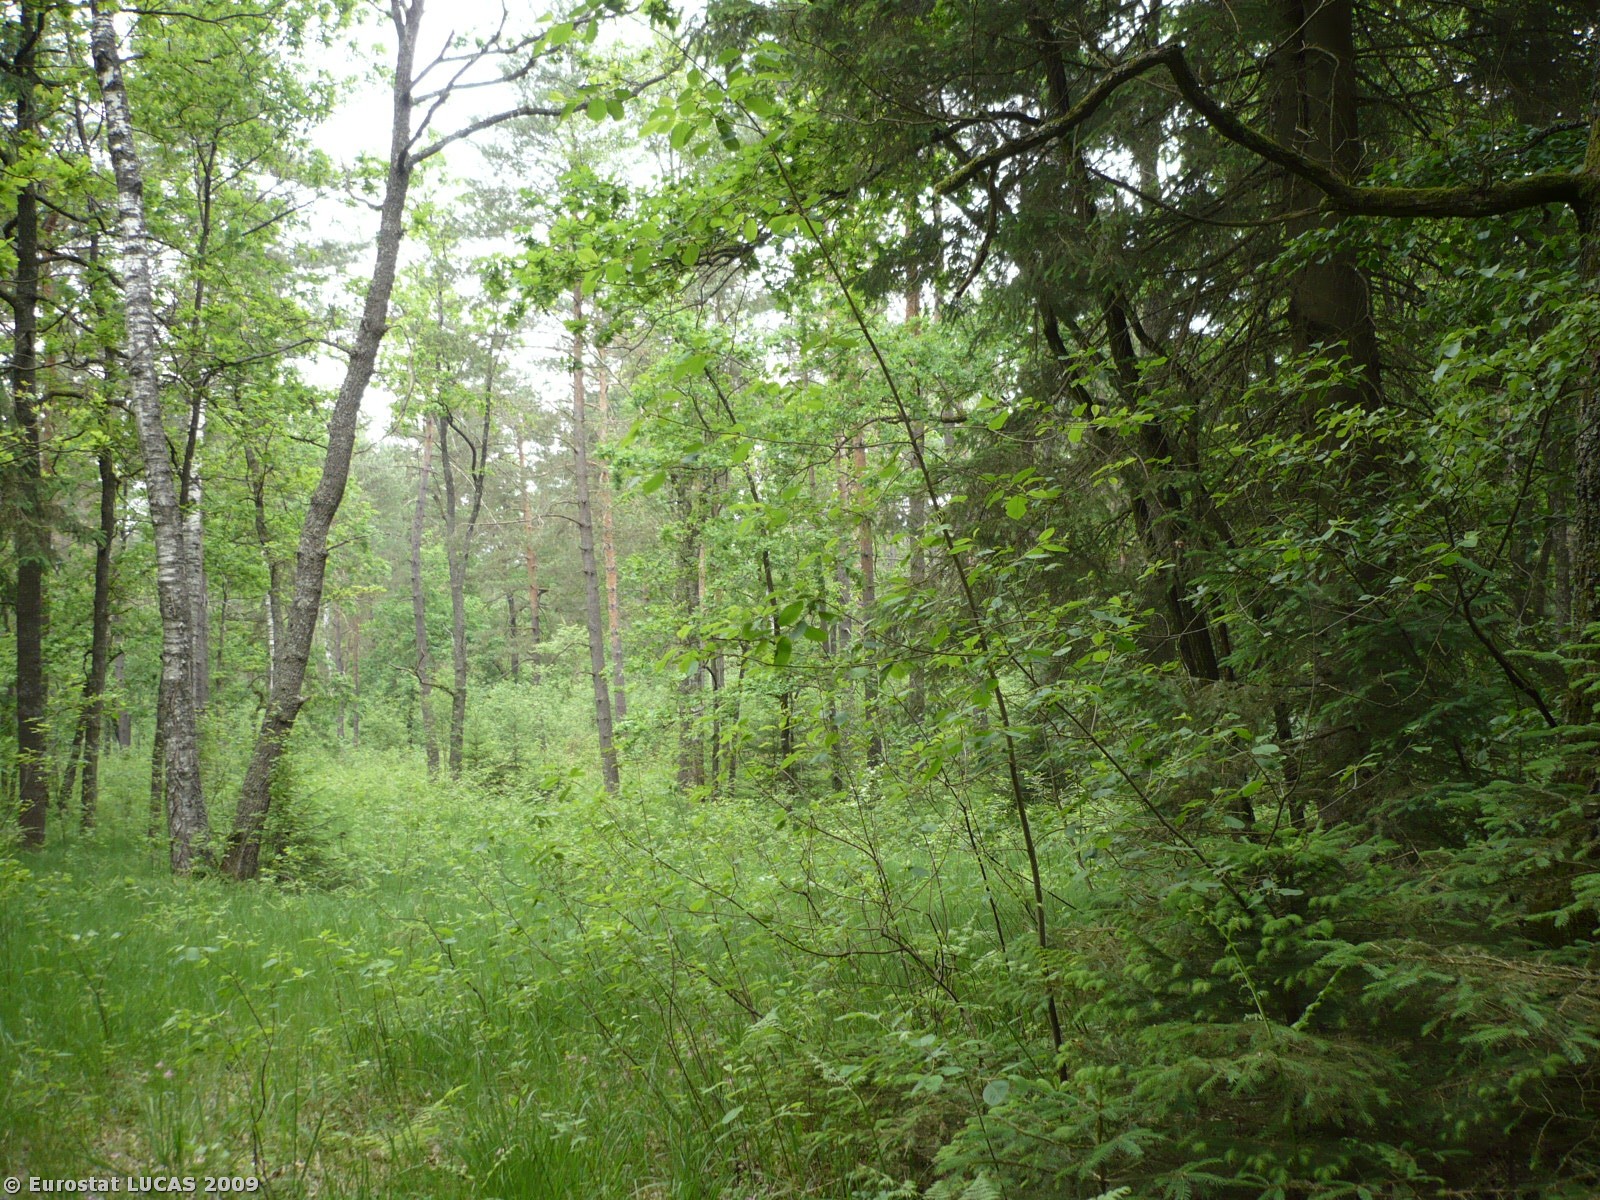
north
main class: Woodland
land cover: Mixed woodland
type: hemiboreal forest and nemoral coniferous forest and mixed broadleaved-coniferous forest
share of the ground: > 75 %
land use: Forestry
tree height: > 5 m
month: May
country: SI
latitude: 46.1721
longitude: 14.3617
